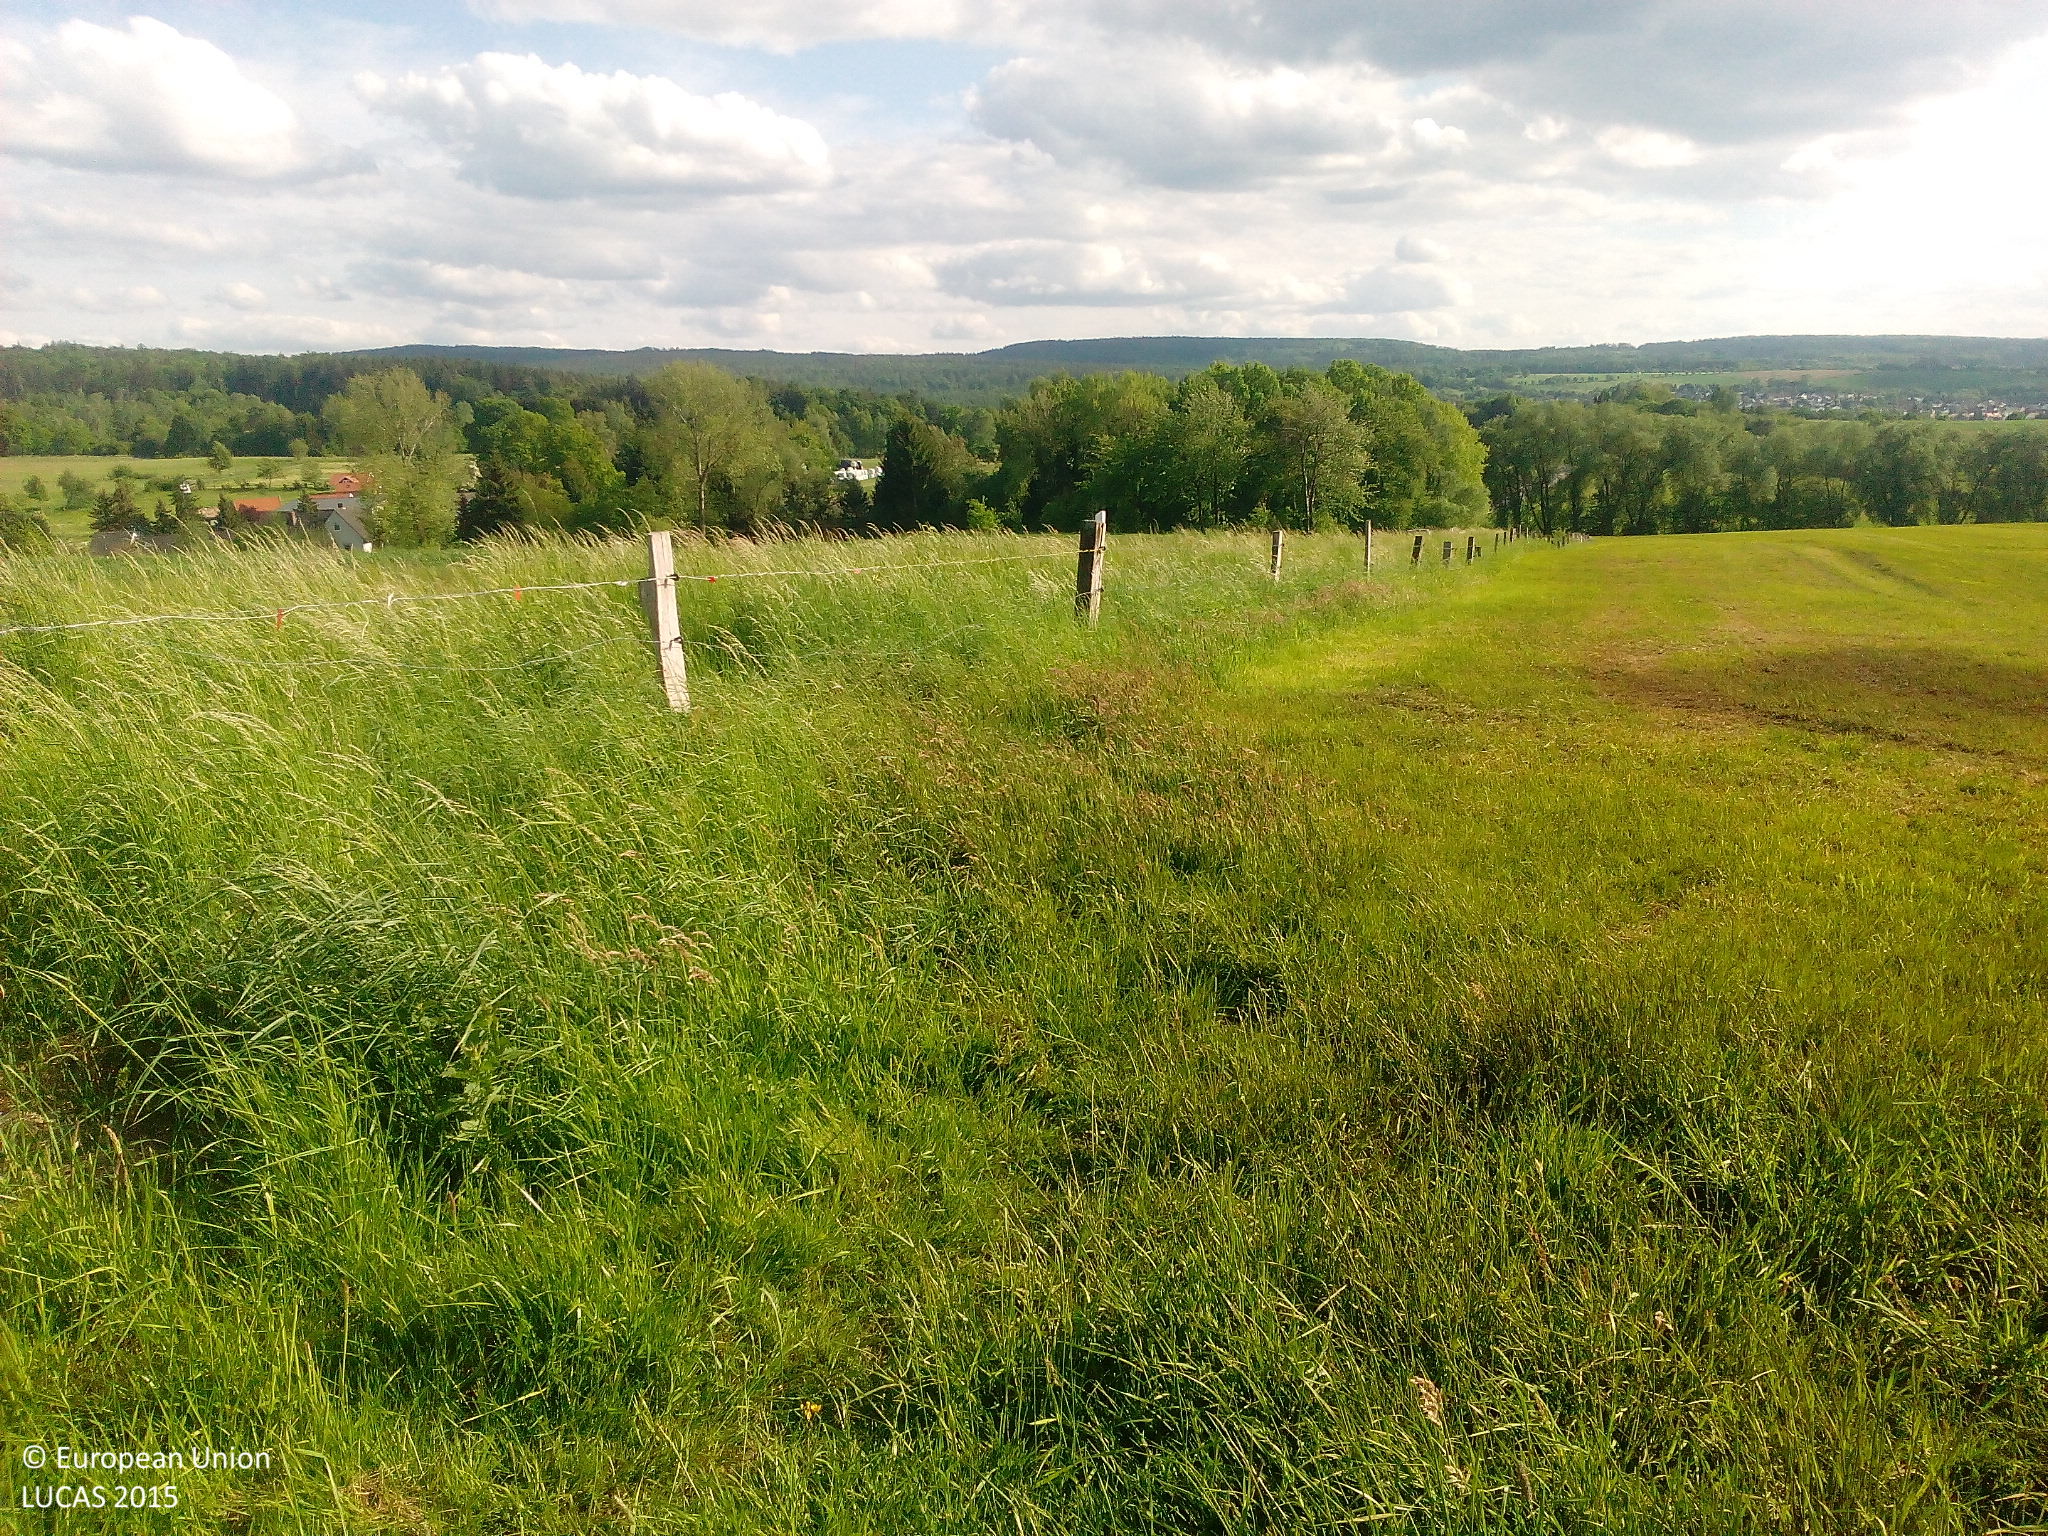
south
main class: Grassland
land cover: Grassland without tree/shrub cover
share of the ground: > 75 %
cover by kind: herbaceous plants 100 %
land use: Agriculture (excluding fallow land and kitchen gardens)
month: May
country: DE
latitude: 51.2984
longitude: 9.6416
